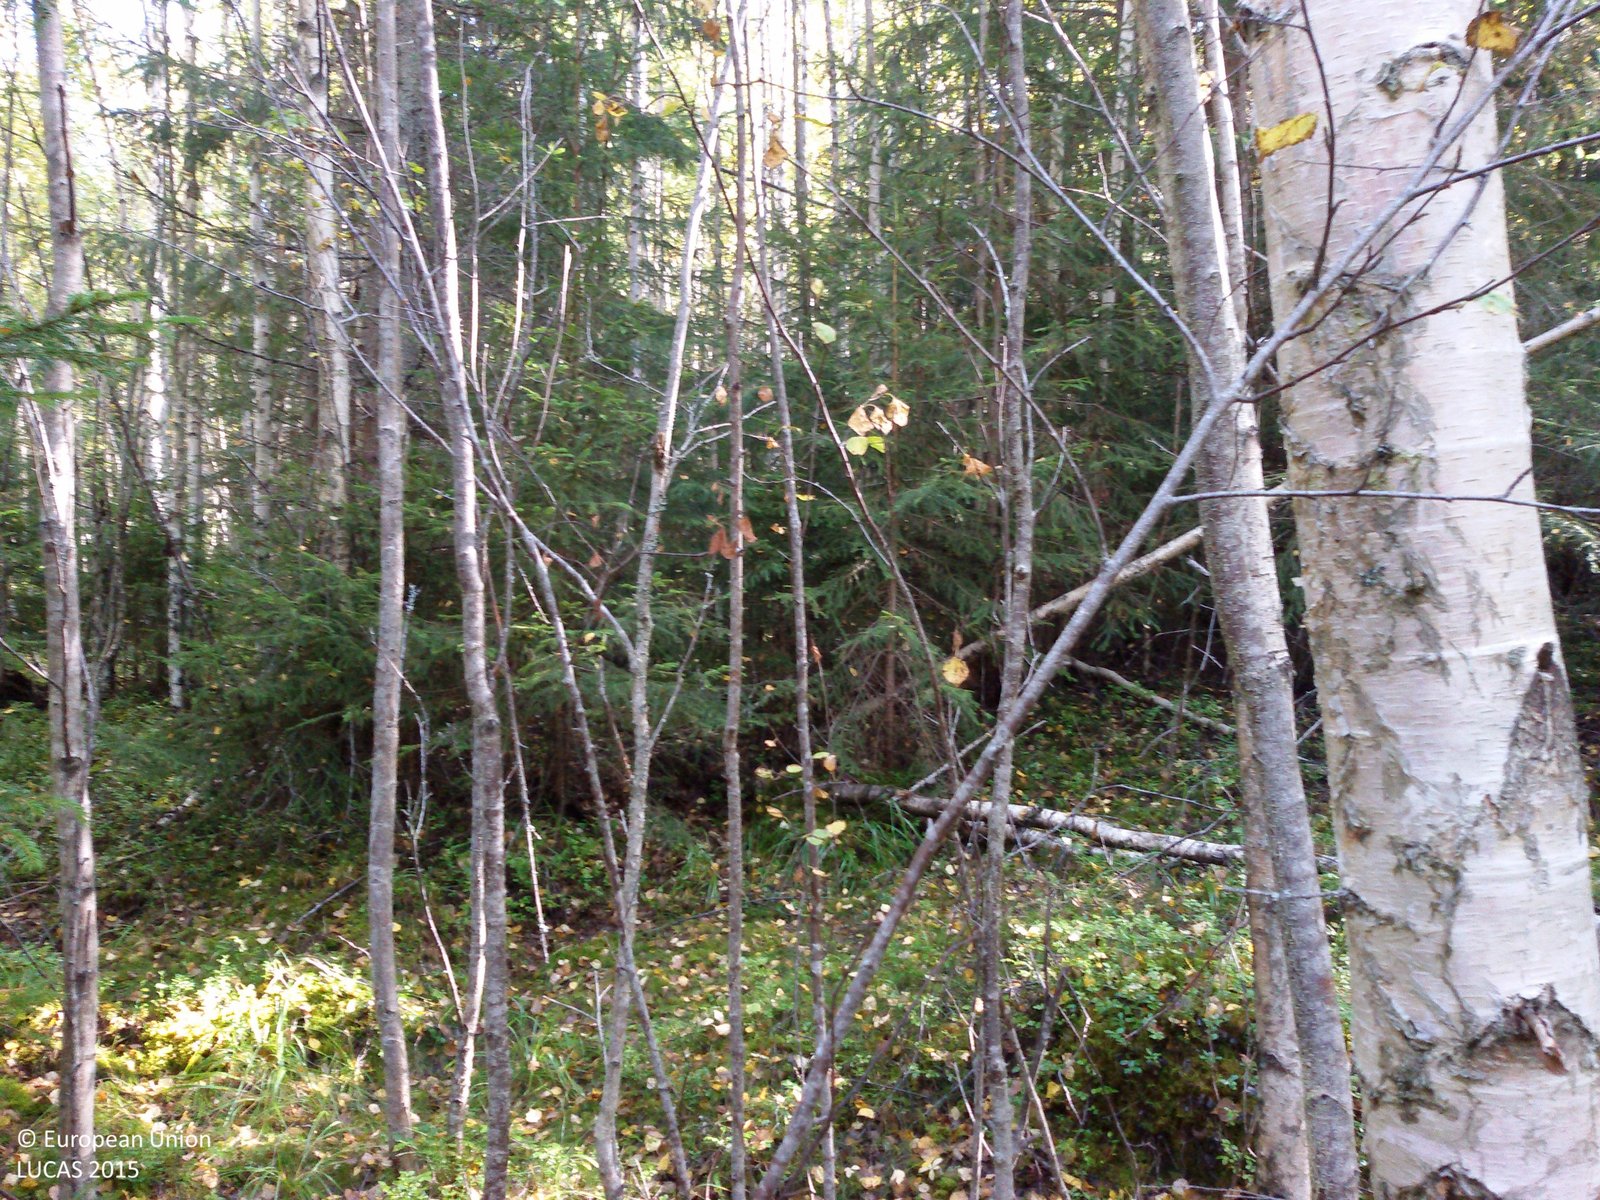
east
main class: Woodland
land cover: Spruce dominated mixed woodland
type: boreal forest
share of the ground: > 75 %
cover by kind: coniferous forest trees 45 %, broadleaved forest trees 45 %, herbaceous plants 5 %, lichens and mosses 5 %
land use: Forestry
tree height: > 5 m
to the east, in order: Spruce dominated mixed woodland; Spruce dominated coniferous woodland
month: September
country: SE
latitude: 60.7517
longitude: 14.7026
